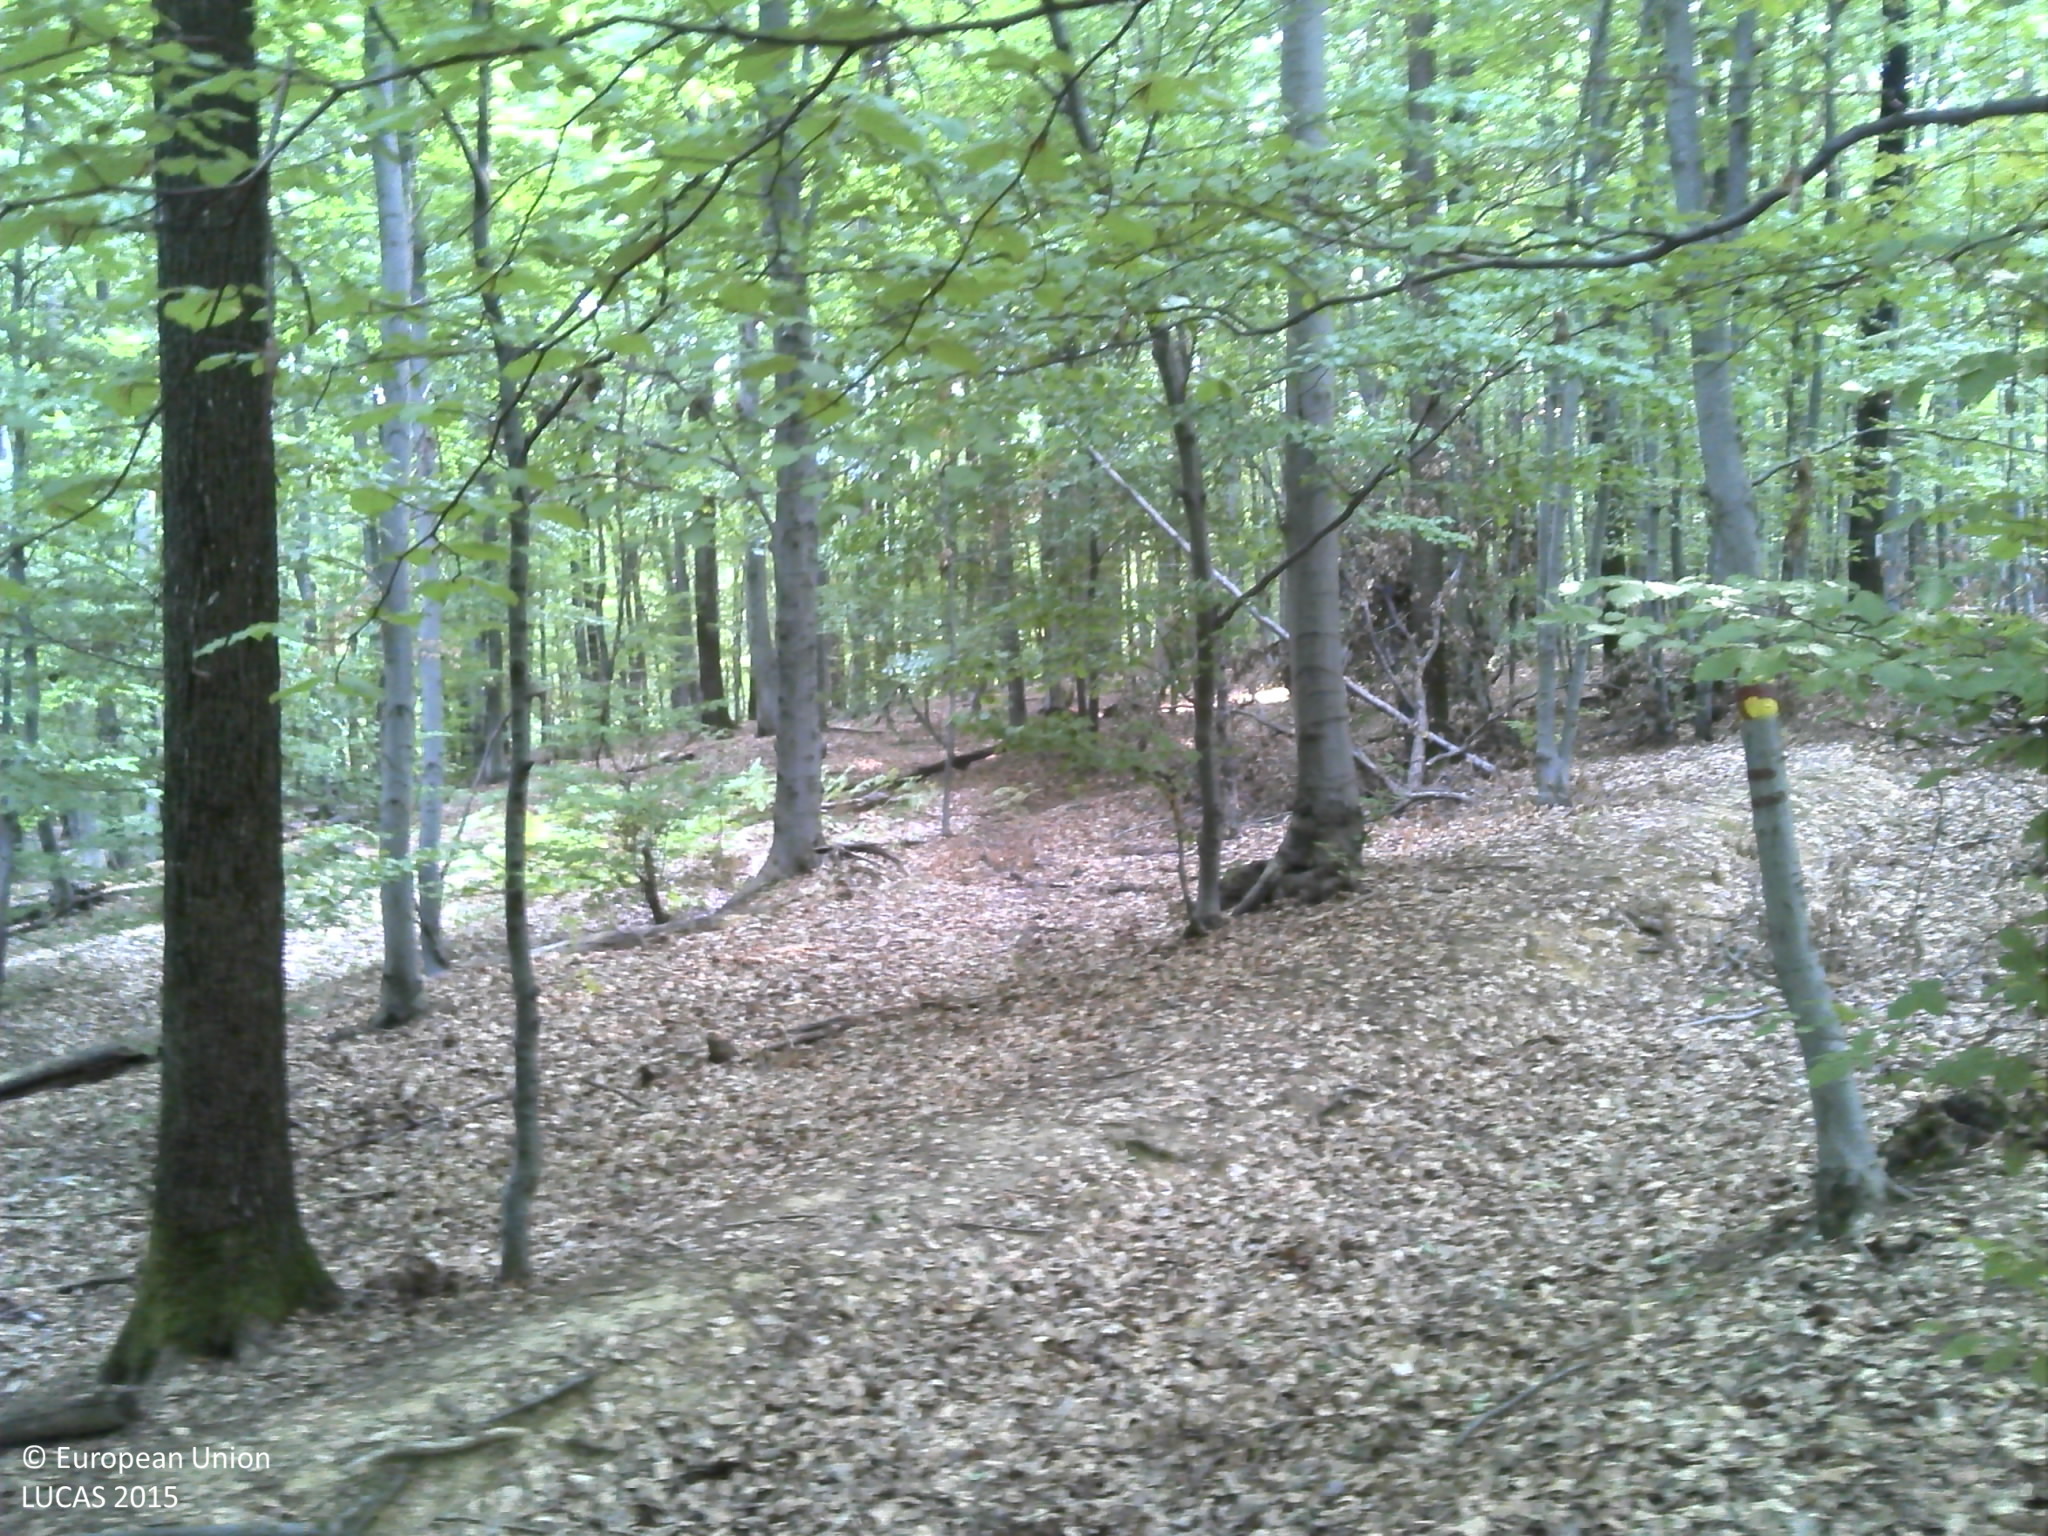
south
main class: Woodland
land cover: Broadleaved woodland
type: acidophilous oak and oak-birch forest
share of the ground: > 75 %
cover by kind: broadleaved forest trees 100 %
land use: Forestry
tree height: > 5 m
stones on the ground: < 10 %
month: August
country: HR
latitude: 45.4959
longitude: 17.9245
